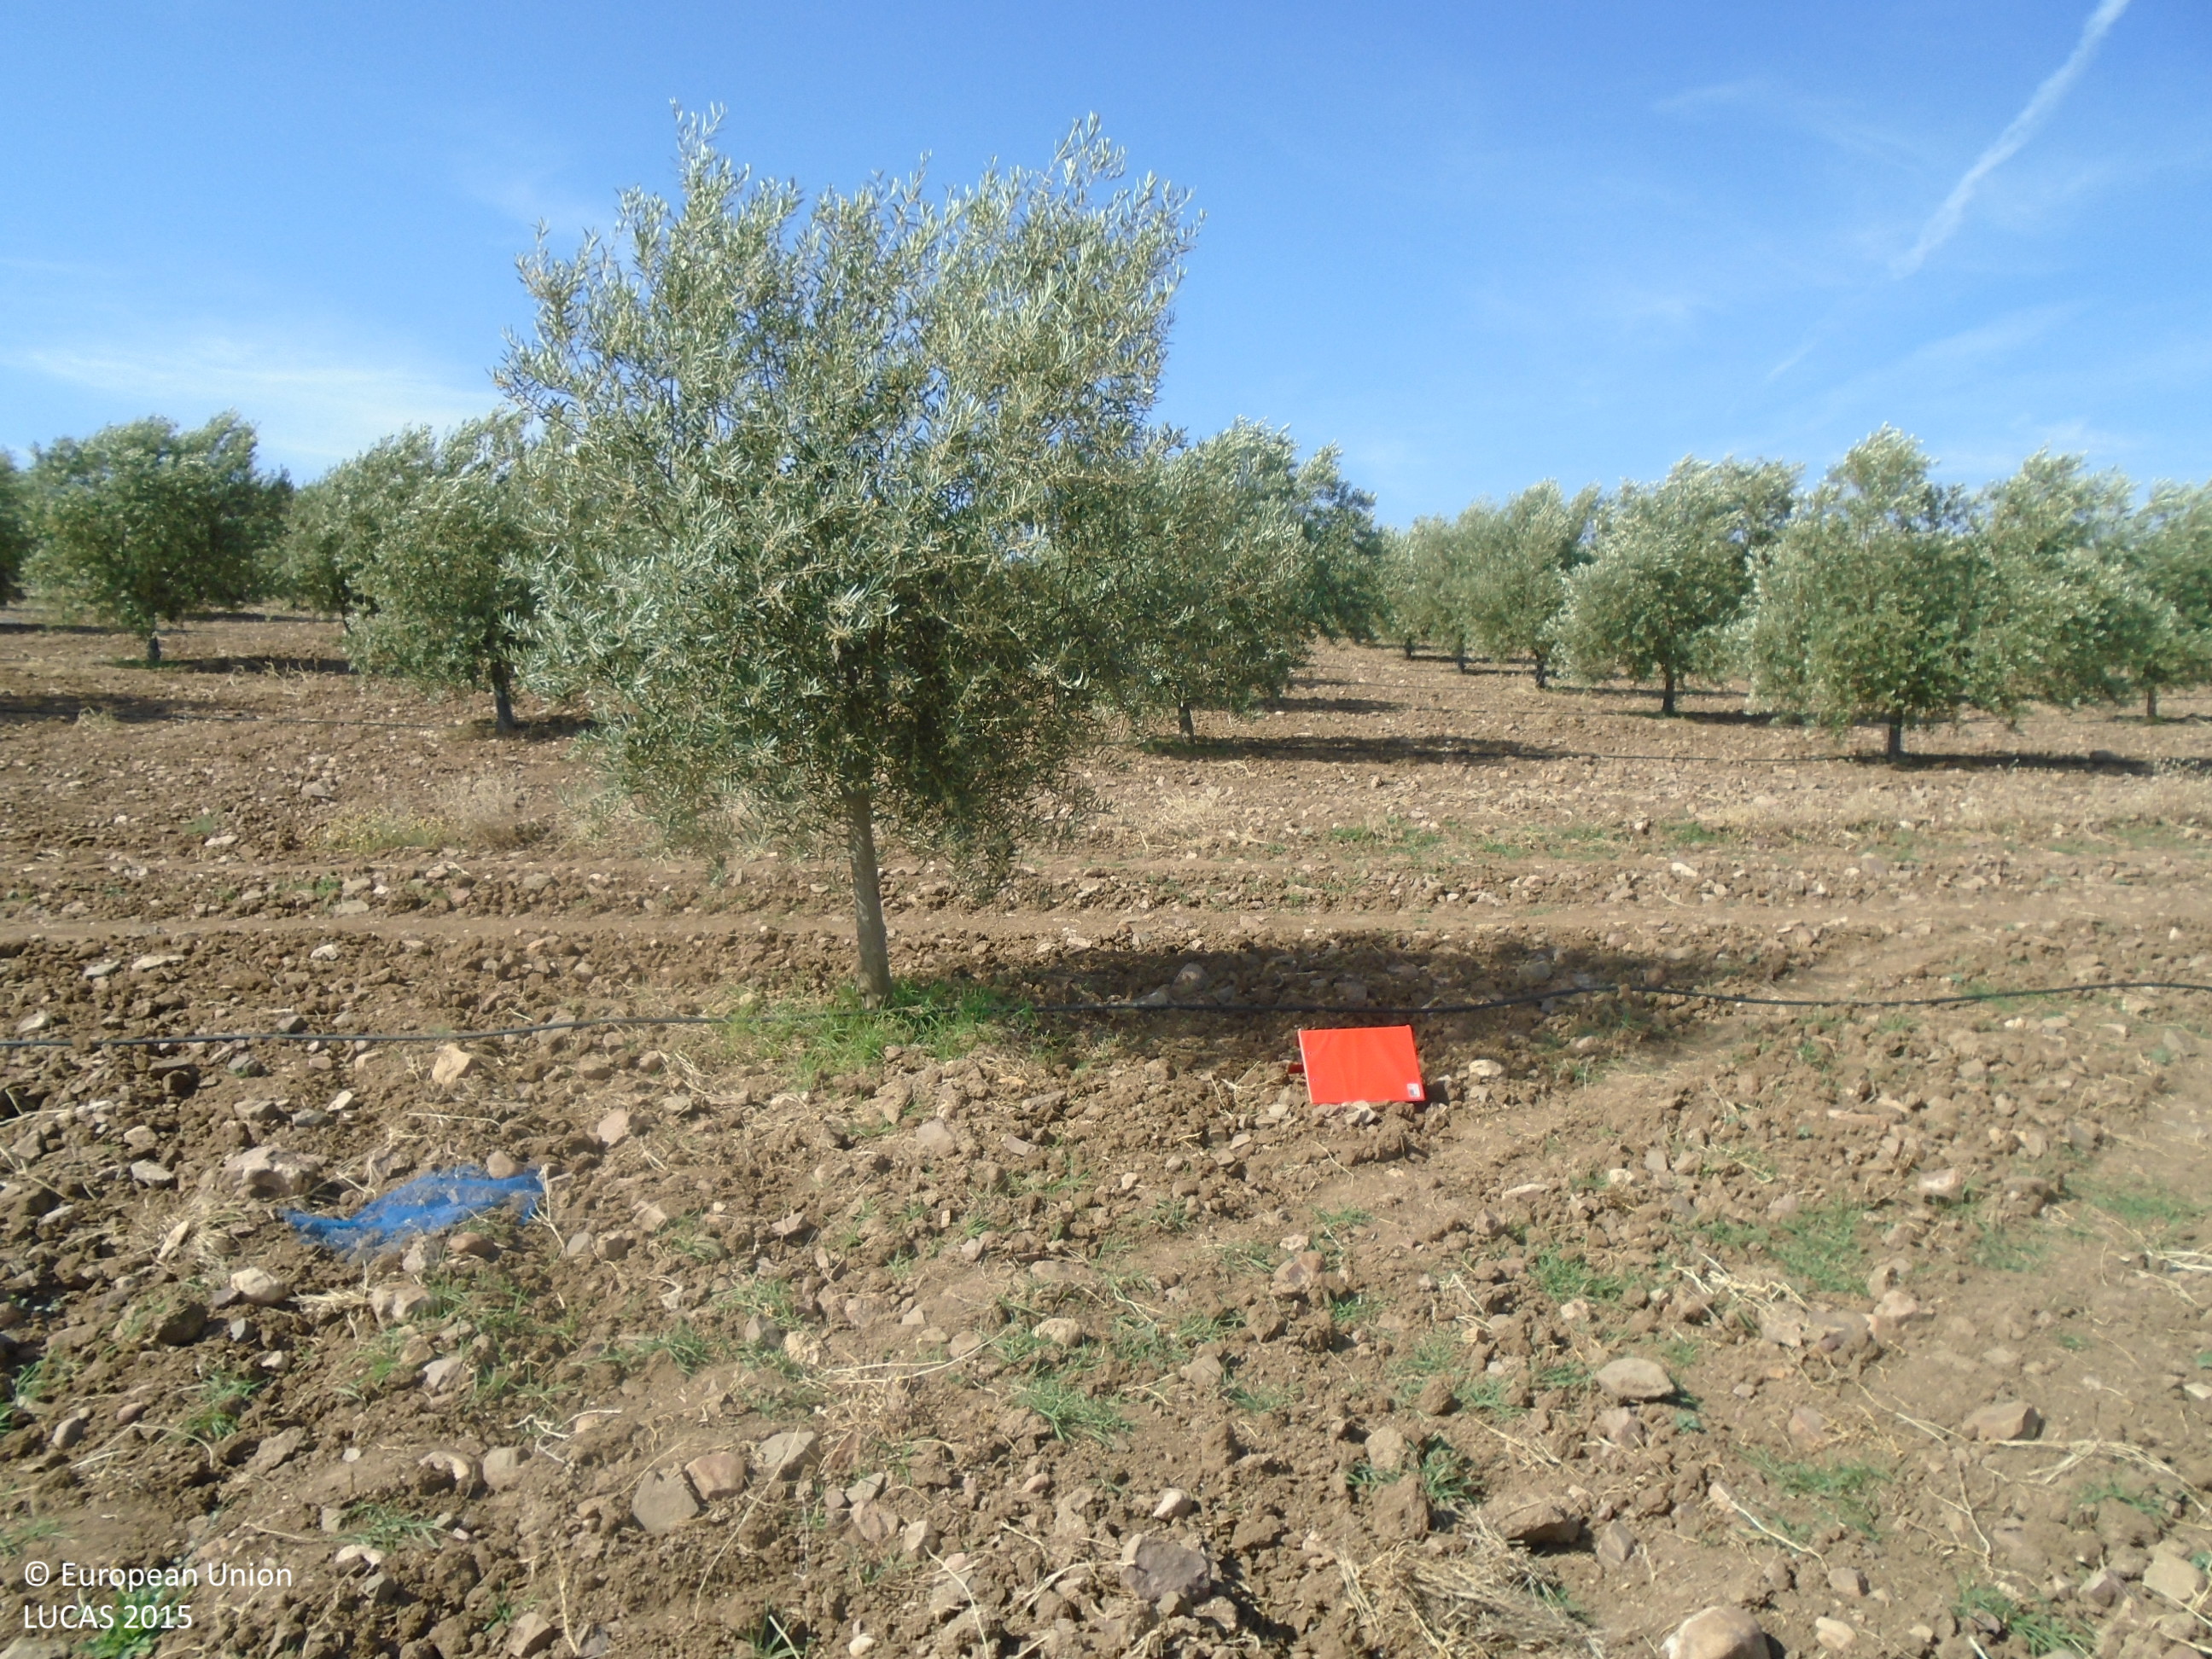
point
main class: Cropland
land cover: Olive groves
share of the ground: 10 - 25 %
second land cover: Other bare soil
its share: > 75 %
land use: Agriculture (excluding fallow land and kitchen gardens)
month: June
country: ES
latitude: 39.8178
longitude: -3.8043
